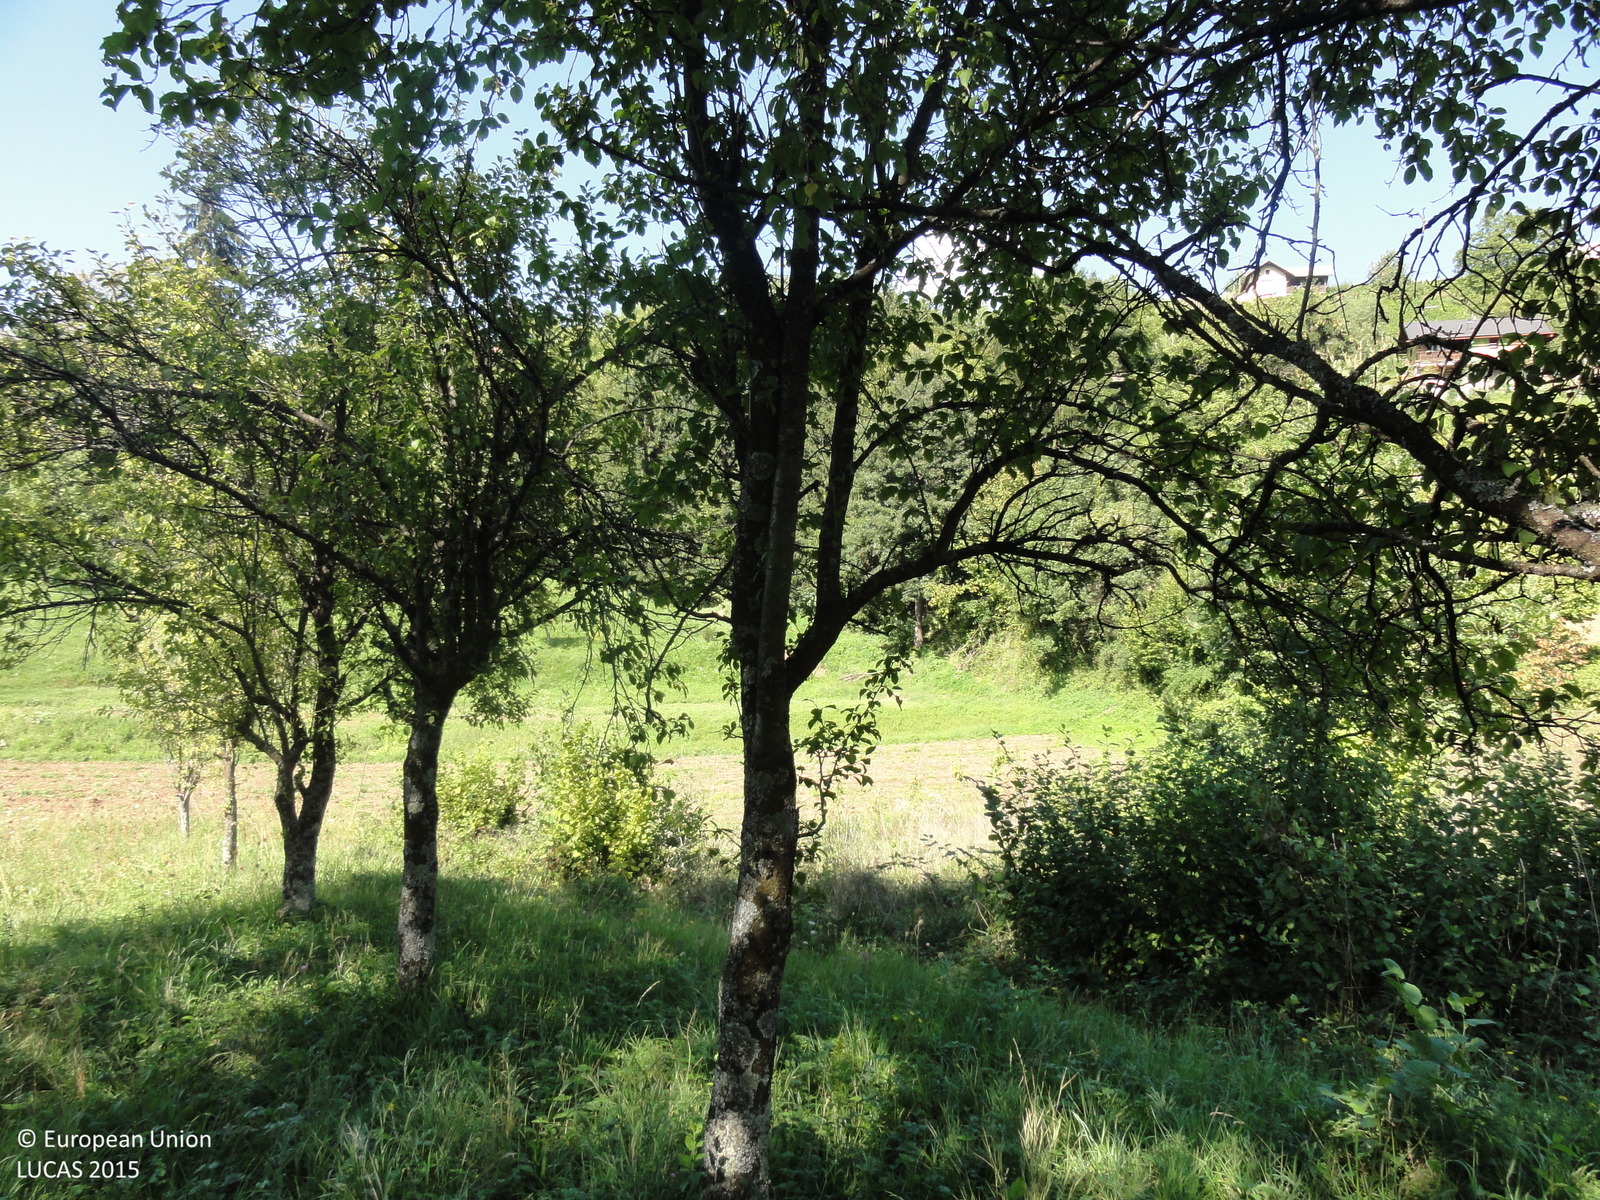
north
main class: Grassland
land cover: Grassland with sparse tree/shrub cover
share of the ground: > 75 %
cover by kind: herbaceous plants 90 %, broadleaved forest trees 5 %, shrubs 5 %
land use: Agriculture (excluding fallow land and kitchen gardens)
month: September
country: SI
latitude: 45.8335
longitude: 15.4426
